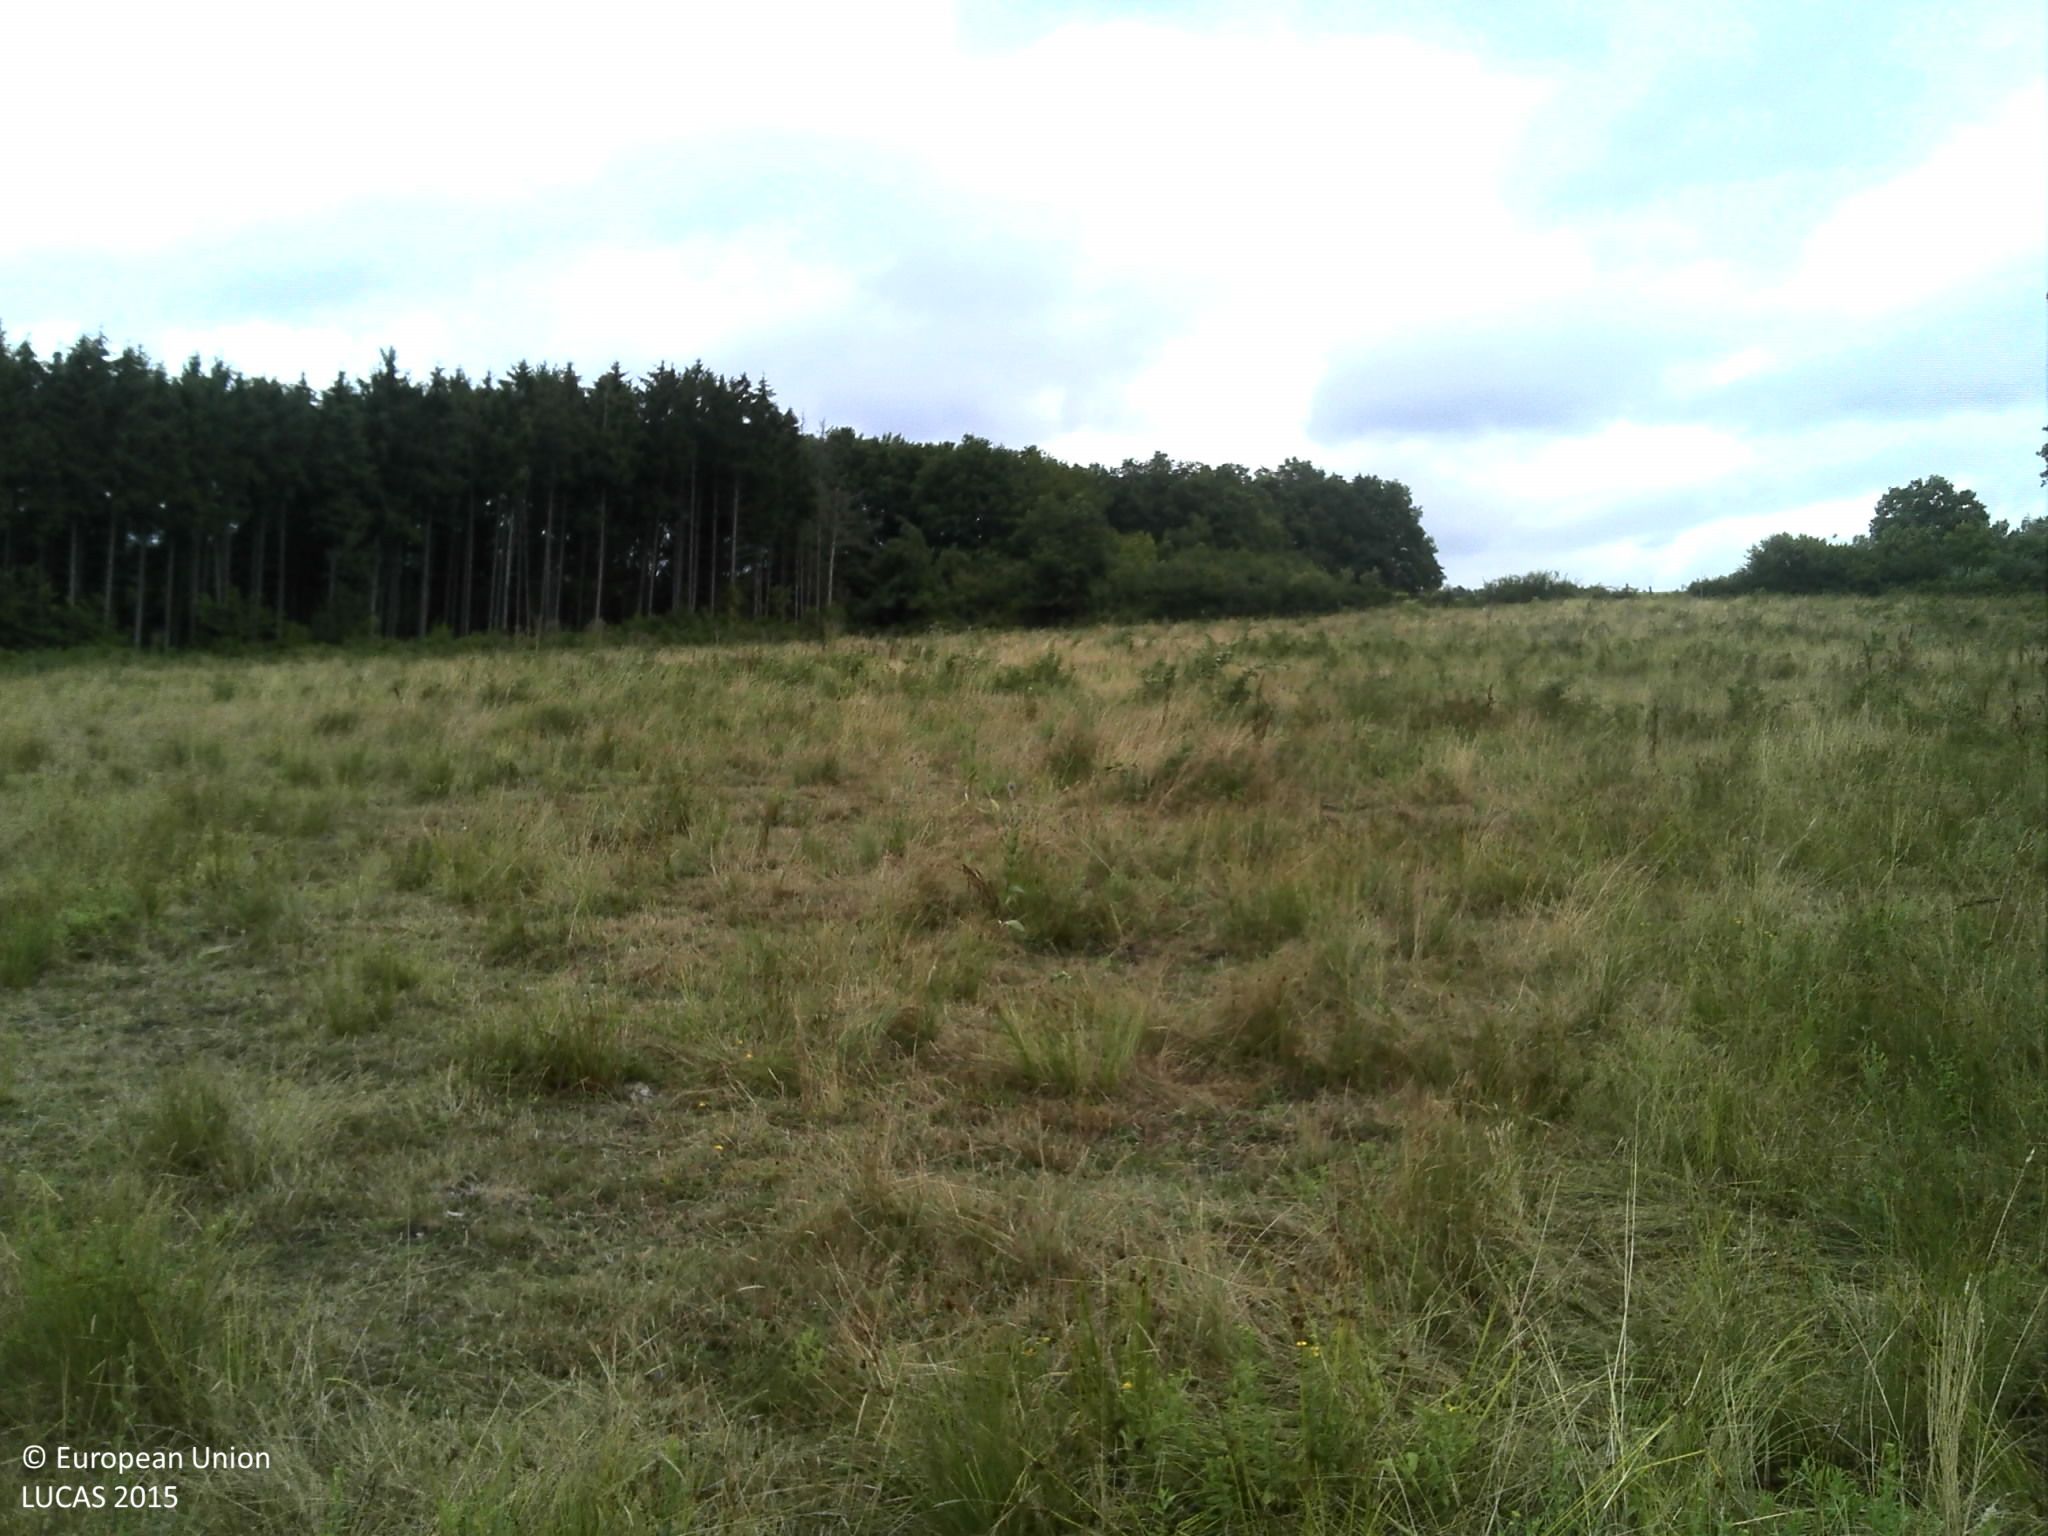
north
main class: Grassland
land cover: Grassland without tree/shrub cover
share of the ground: > 75 %
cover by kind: herbaceous plants 100 %
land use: Agriculture (excluding fallow land and kitchen gardens)
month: July
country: FR
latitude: 49.4489
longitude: 4.7139
